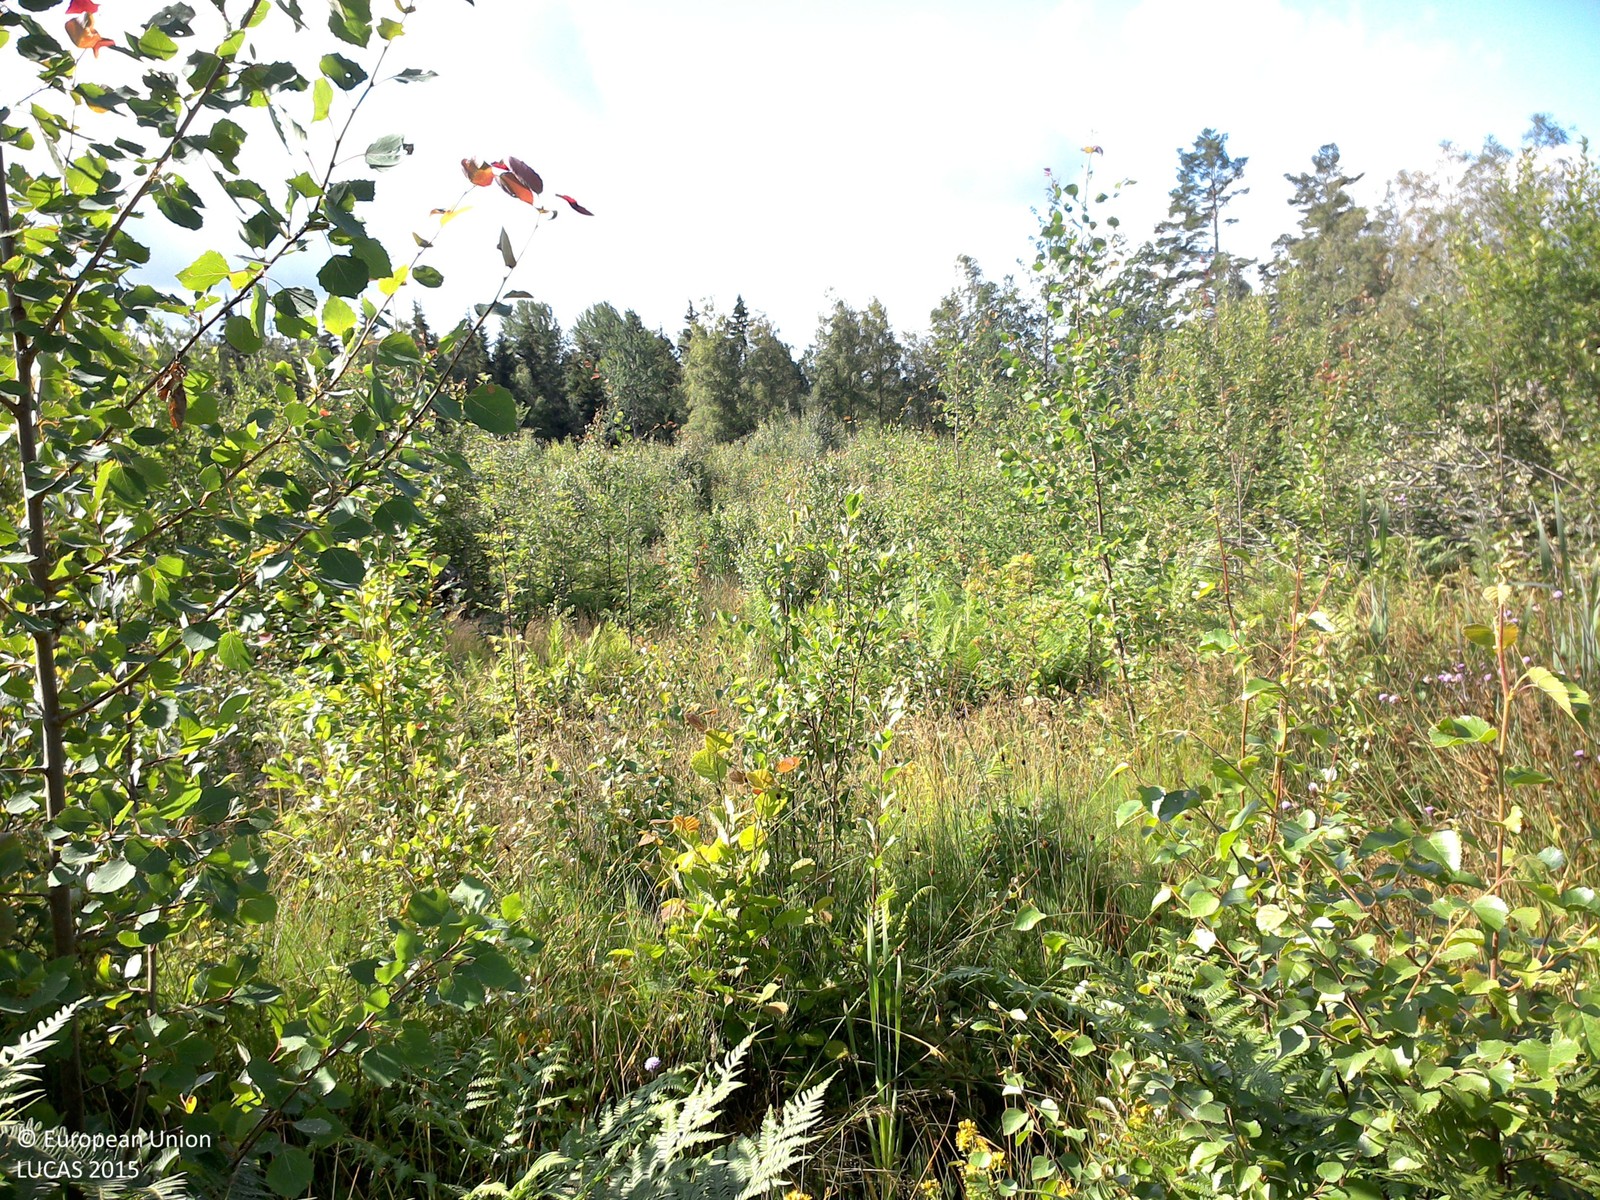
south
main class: Woodland
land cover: Broadleaved woodland
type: boreal forest
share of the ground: > 75 %
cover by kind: broadleaved forest trees 75 %, herbaceous plants 25 %
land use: Forestry
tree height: < 5 m
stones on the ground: < 10 %
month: July
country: SE
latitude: 57.9533
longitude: 14.8106
